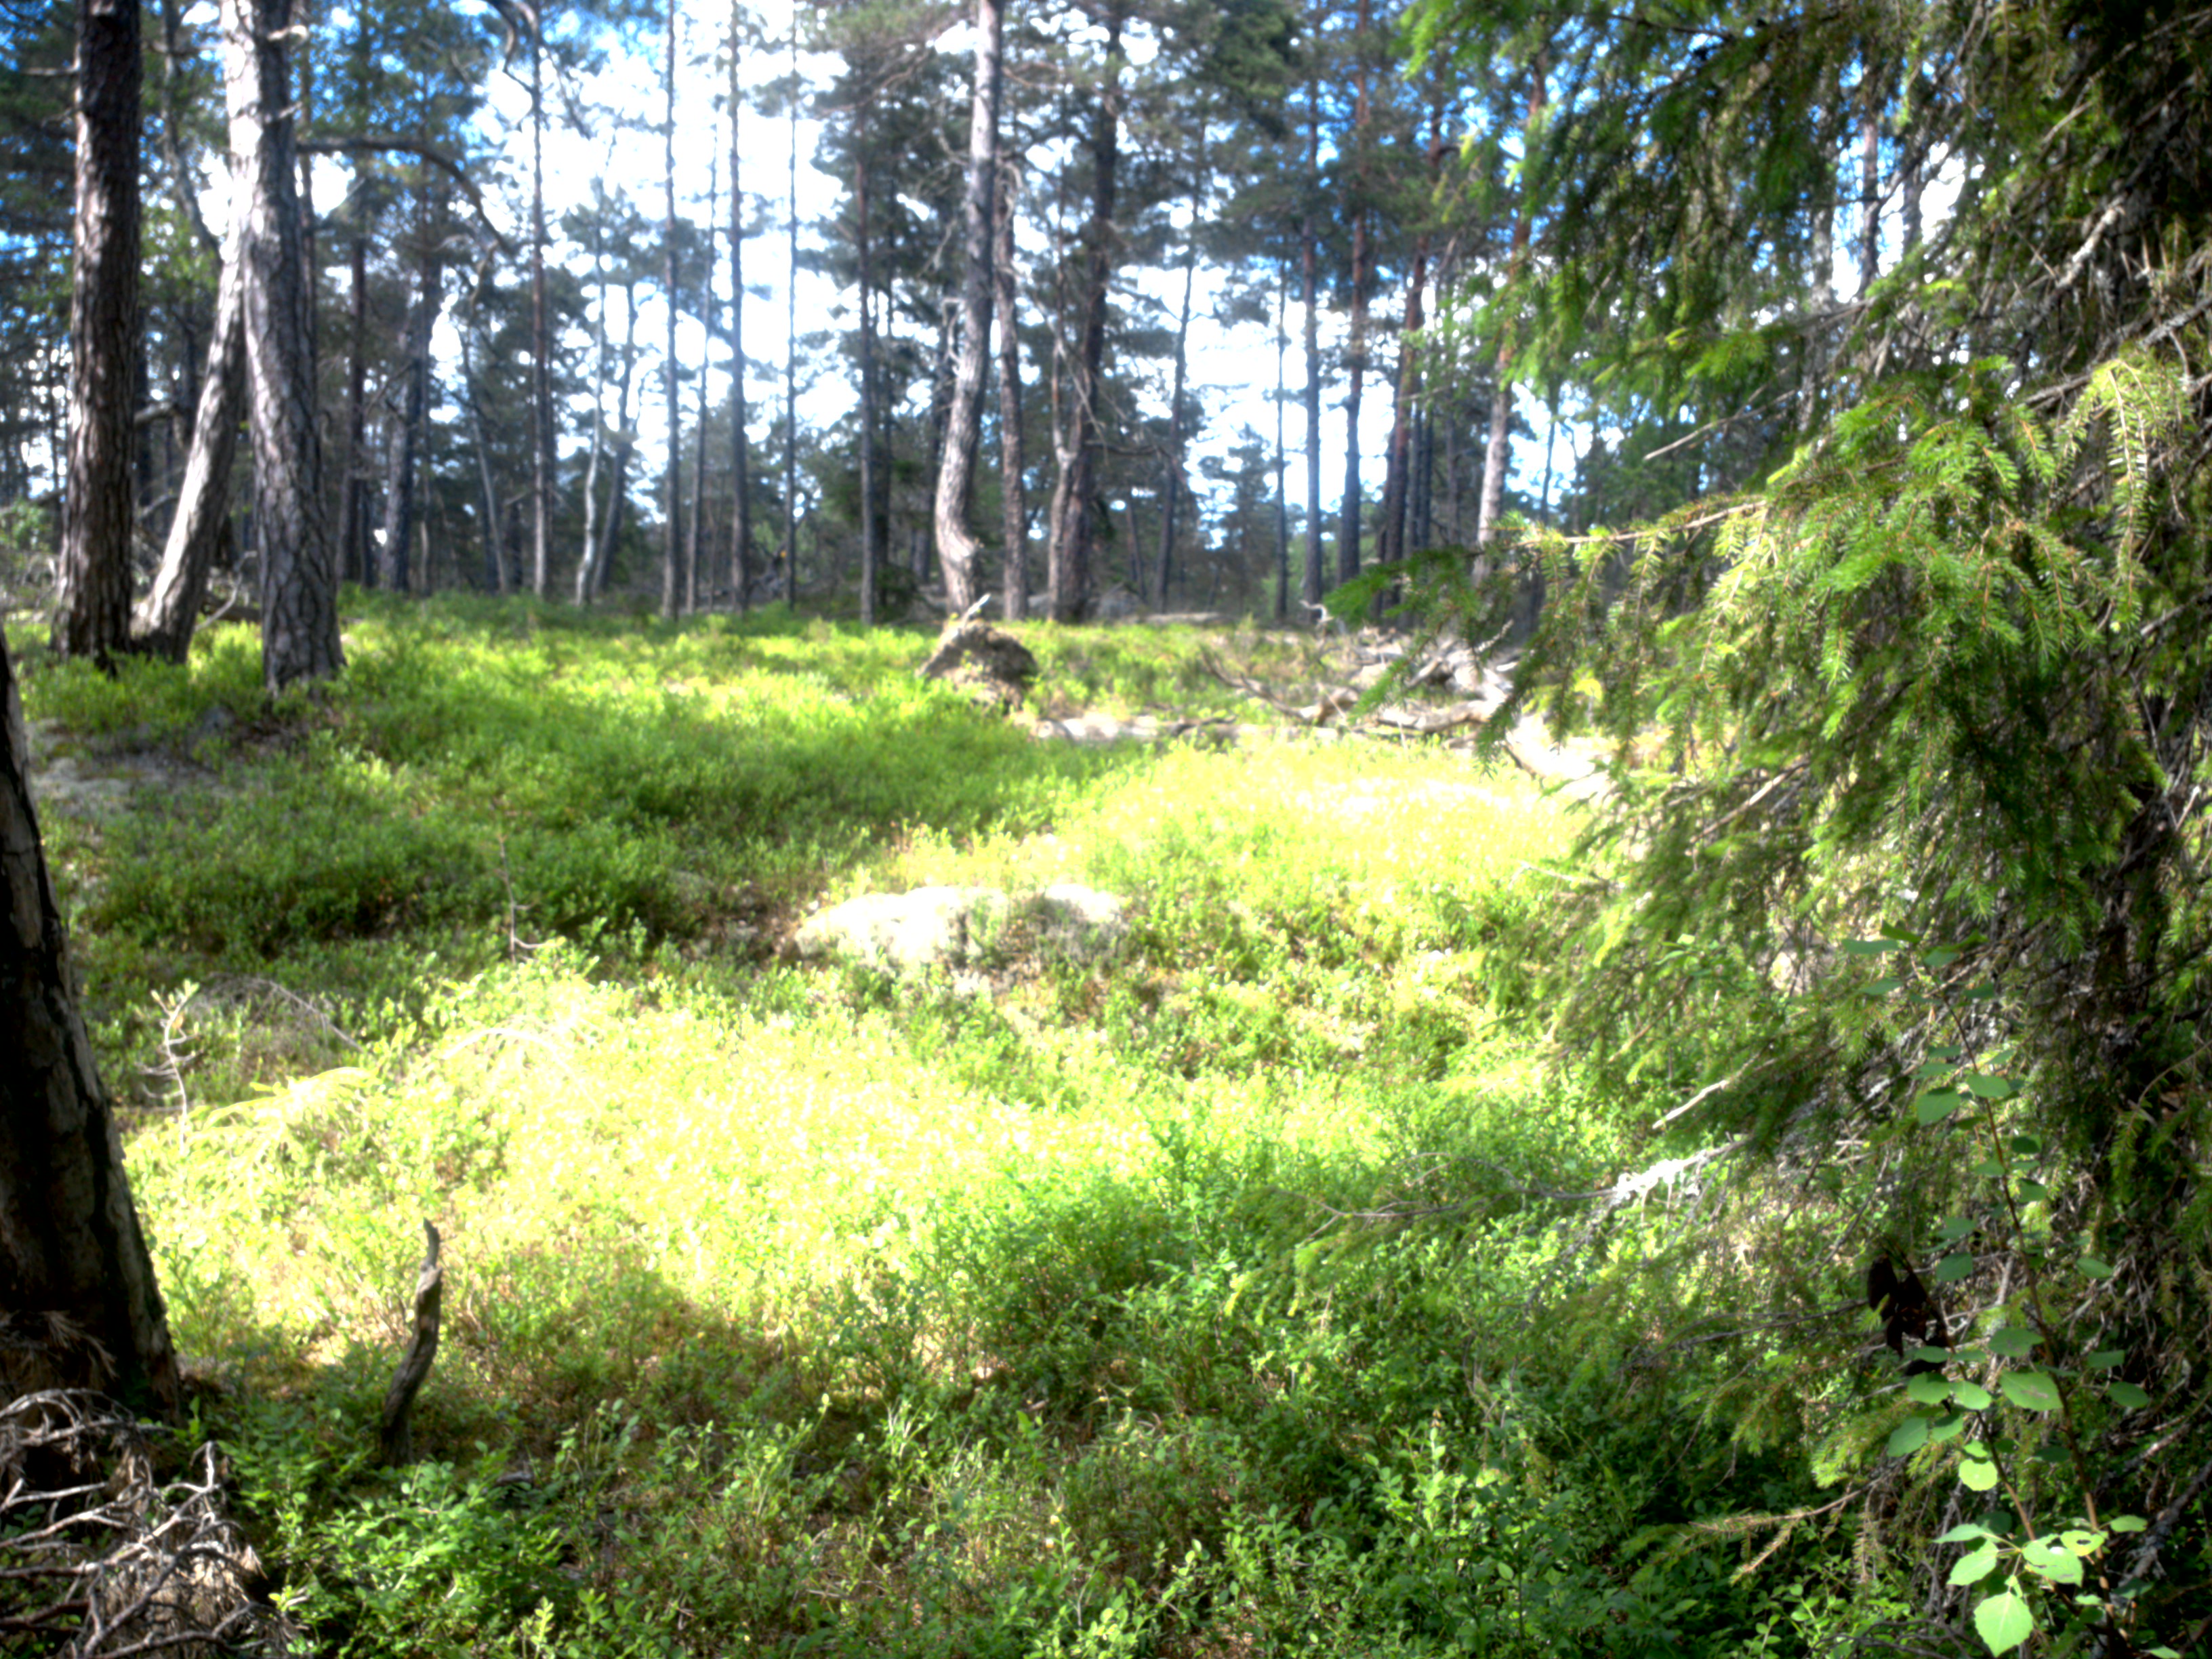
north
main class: Woodland
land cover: Pine dominated coniferous woodland
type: boreal forest
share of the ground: 25 - 50 %
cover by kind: coniferous forest trees 50 %, shrubs 45 %, lichens and mosses 5 %
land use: Amenities, museums, leisure
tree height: > 5 m
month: June
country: SE
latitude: 59.1788
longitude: 18.2419
